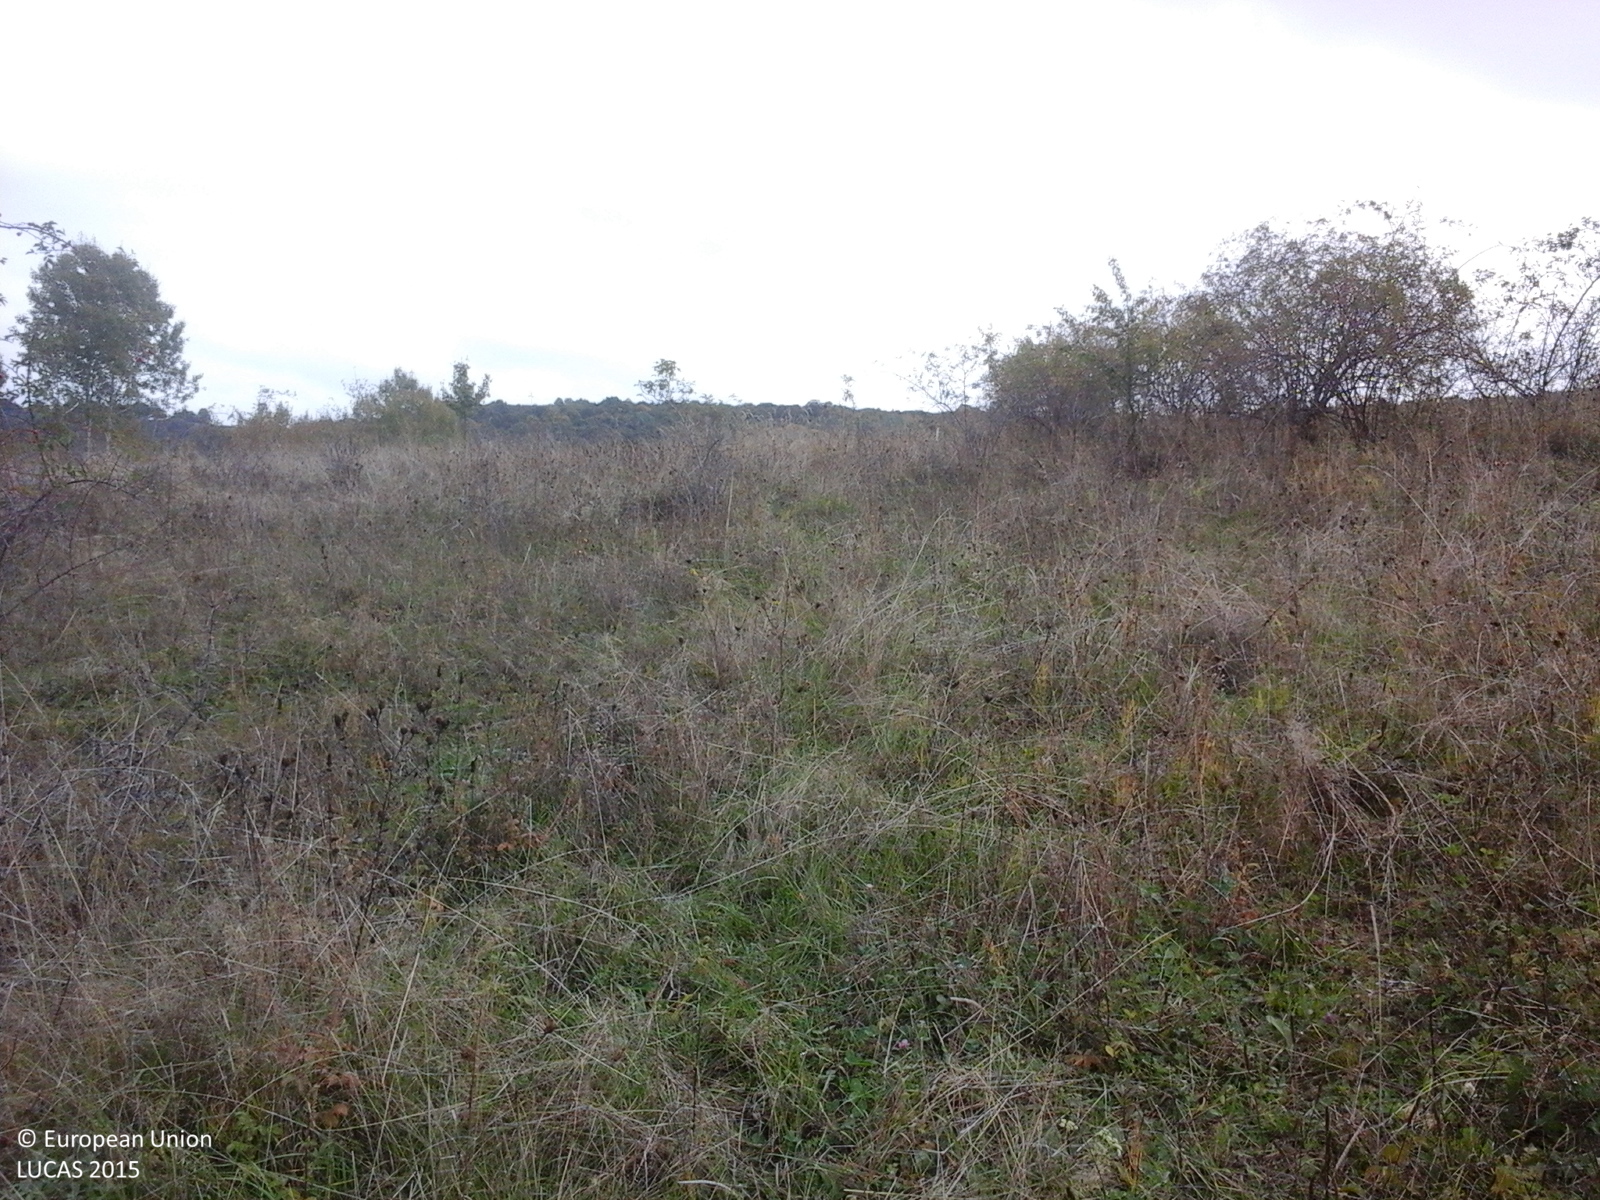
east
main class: Grassland
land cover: Grassland with sparse tree/shrub cover
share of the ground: > 75 %
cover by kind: herbaceous plants 90 %, broadleaved forest trees 5 %, shrubs 5 %
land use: Agriculture (excluding fallow land and kitchen gardens)
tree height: > 5 m
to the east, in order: Grassland with sparse tree/shrub cover; Shrubland with sparse tree cover; Grassland without tree/shrub cover; Shrubland with sparse tree cover; Grassland without tree/shrub cover; Broadleaved woodland; Grassland without tree/shrub cover
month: October
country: RO
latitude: 45.8543
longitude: 24.2042
